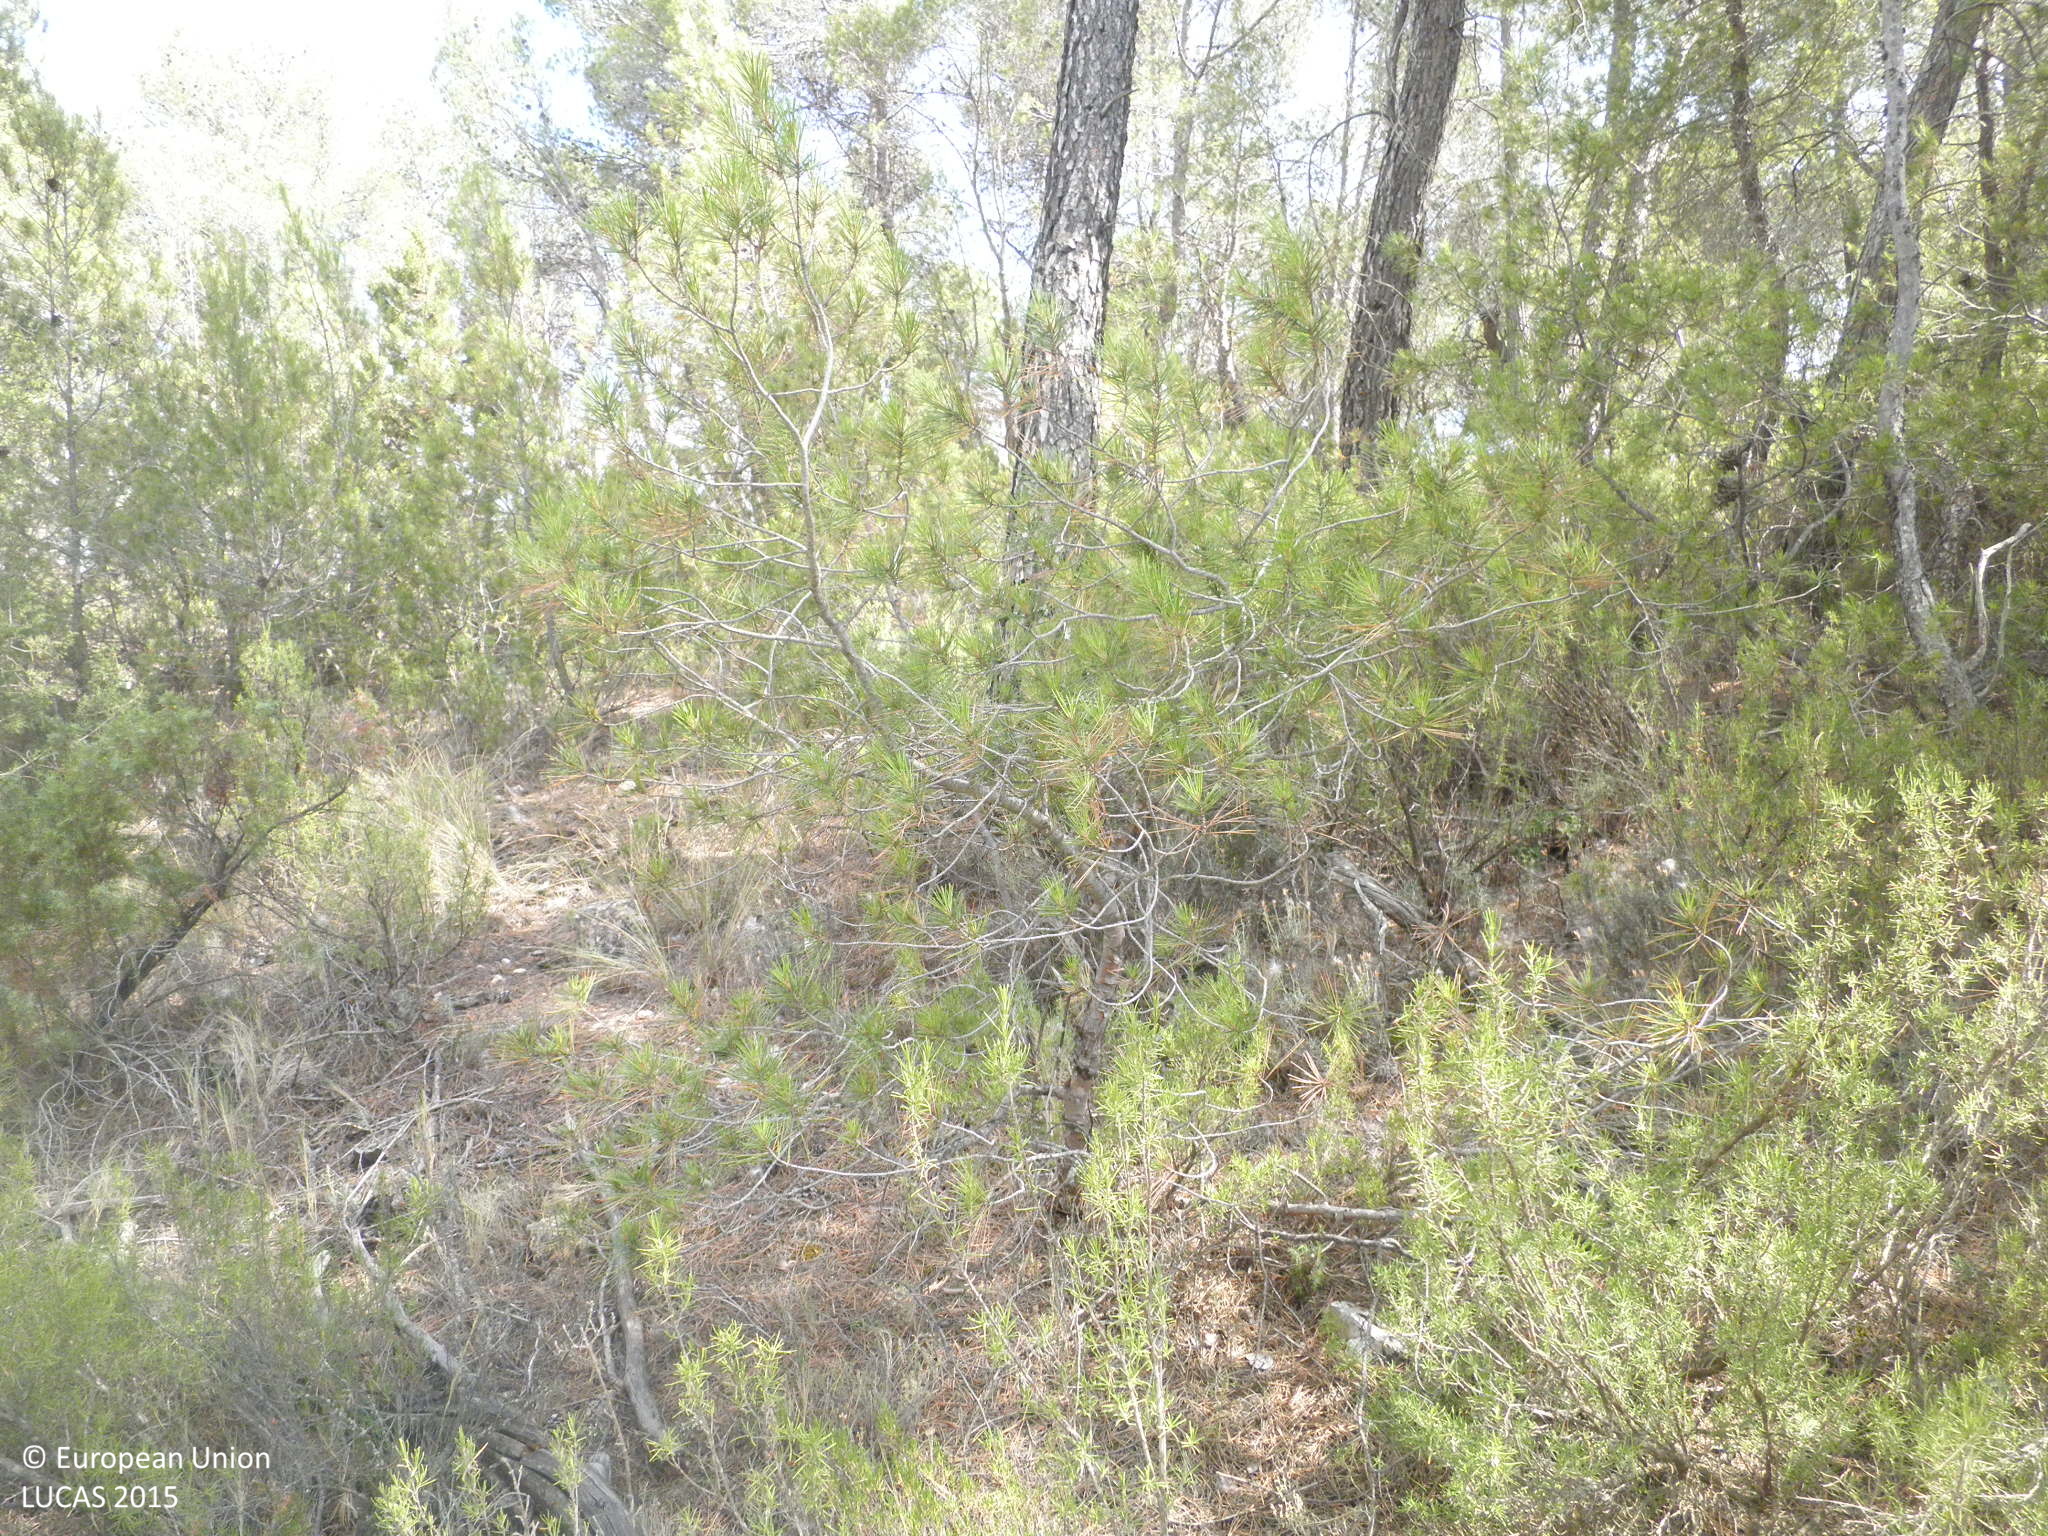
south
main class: Woodland
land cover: Pine dominated coniferous woodland
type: coniferous forest of the mediterranean region
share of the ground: 50 - 75 %
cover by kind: coniferous forest trees 50 %, shrubs 30 %, herbaceous plants 10 %, unconsolidated bare surface 10 %
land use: Semi-natural and natural areas not in use
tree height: > 5 m
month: July
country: ES
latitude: 39.6289
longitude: -1.6219
